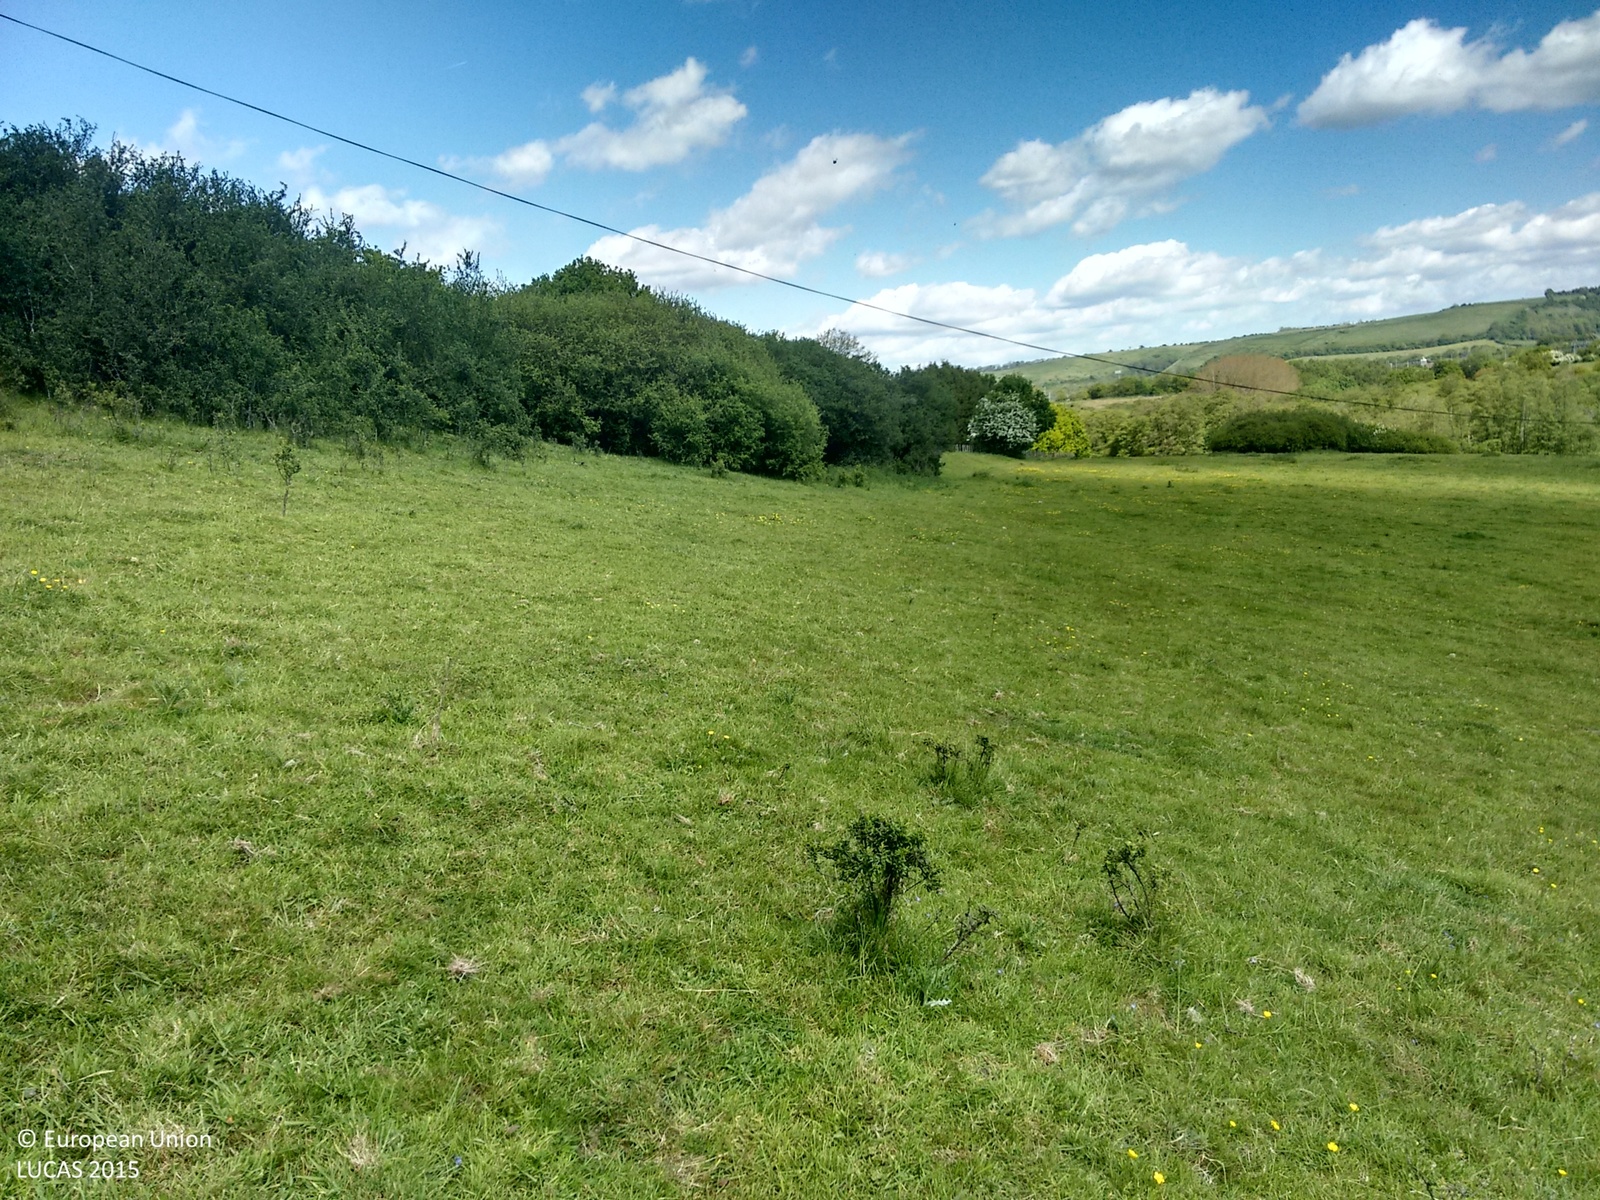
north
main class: Grassland
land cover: Grassland with sparse tree/shrub cover
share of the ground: > 75 %
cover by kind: herbaceous plants 85 %, shrubs 10 %, broadleaved forest trees 5 %
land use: Amenities, museums, leisure
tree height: < 5 m
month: May
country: GB
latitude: 51.0849
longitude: 1.1123
